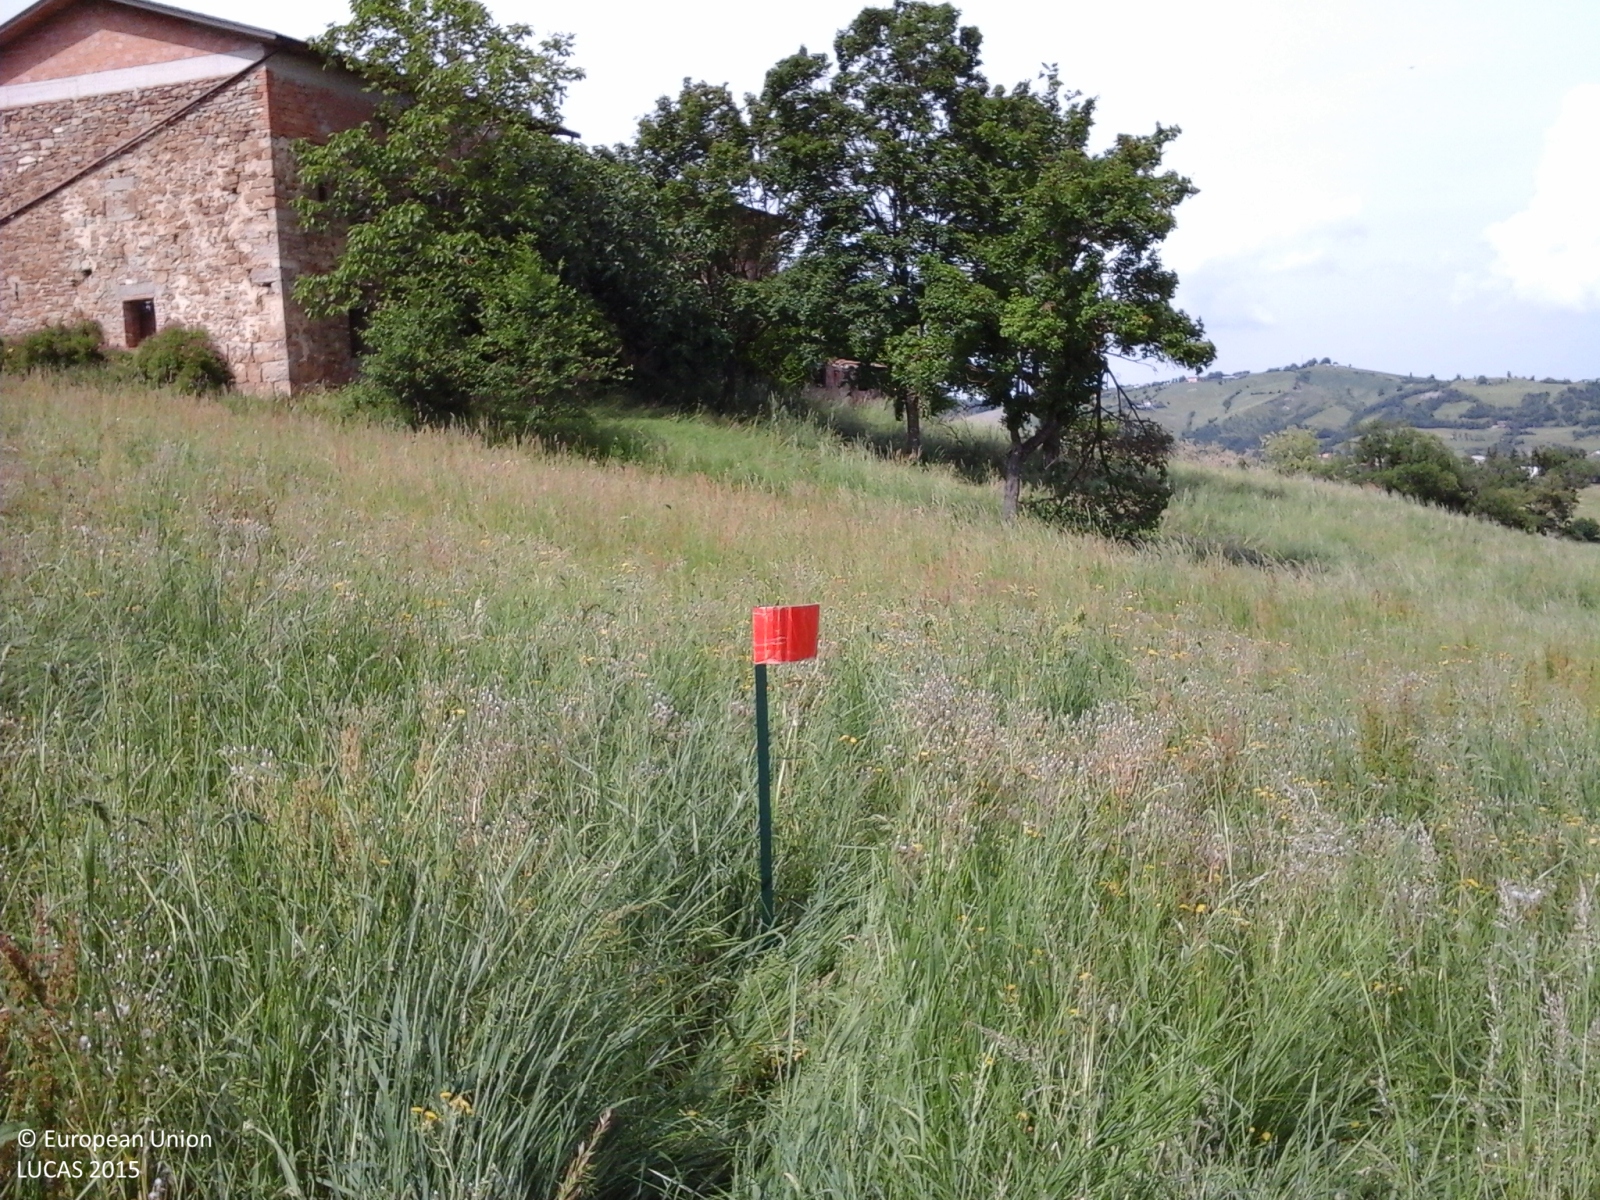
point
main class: Grassland
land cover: Spontaneously vegetated surfaces
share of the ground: > 75 %
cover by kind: herbaceous plants 100 %
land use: Agriculture (excluding fallow land and kitchen gardens)
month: May
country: IT
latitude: 44.3479
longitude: 10.7384
